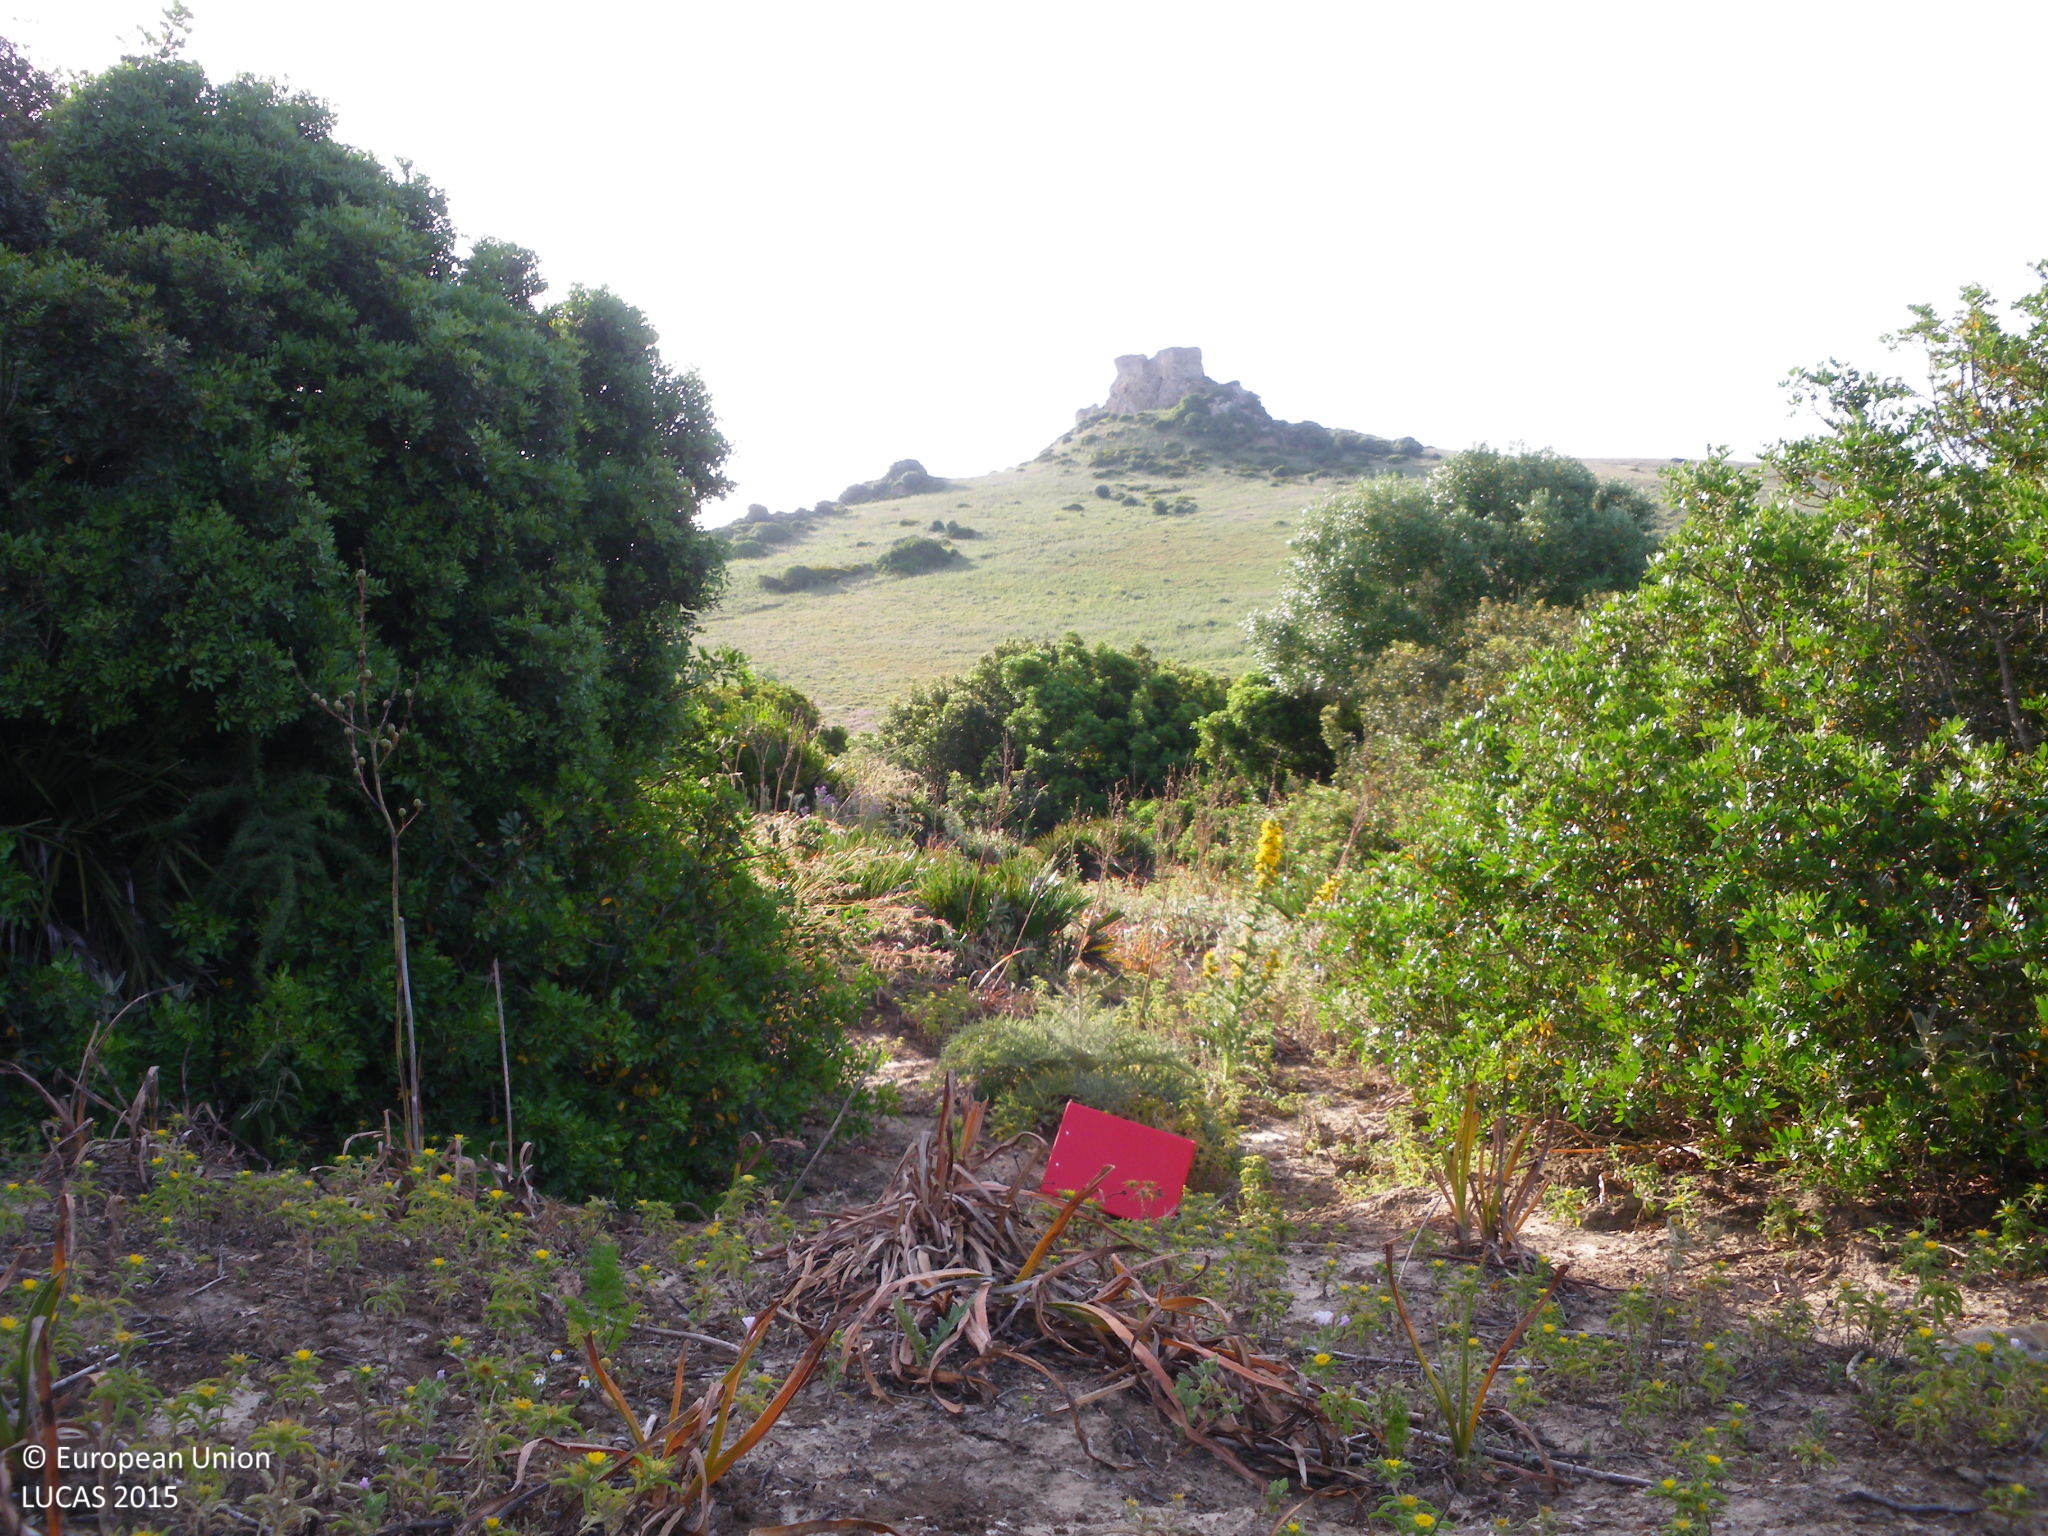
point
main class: Shrubland
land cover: Shrubland with sparse tree cover
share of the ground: 50 - 75 %
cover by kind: shrubs 55 %, herbaceous plants 30 %, unconsolidated bare surface 10 %, broadleaved forest trees 5 %
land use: Agriculture (excluding fallow land and kitchen gardens)
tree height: > 5 m
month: May
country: ES
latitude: 36.4449
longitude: -5.8564
